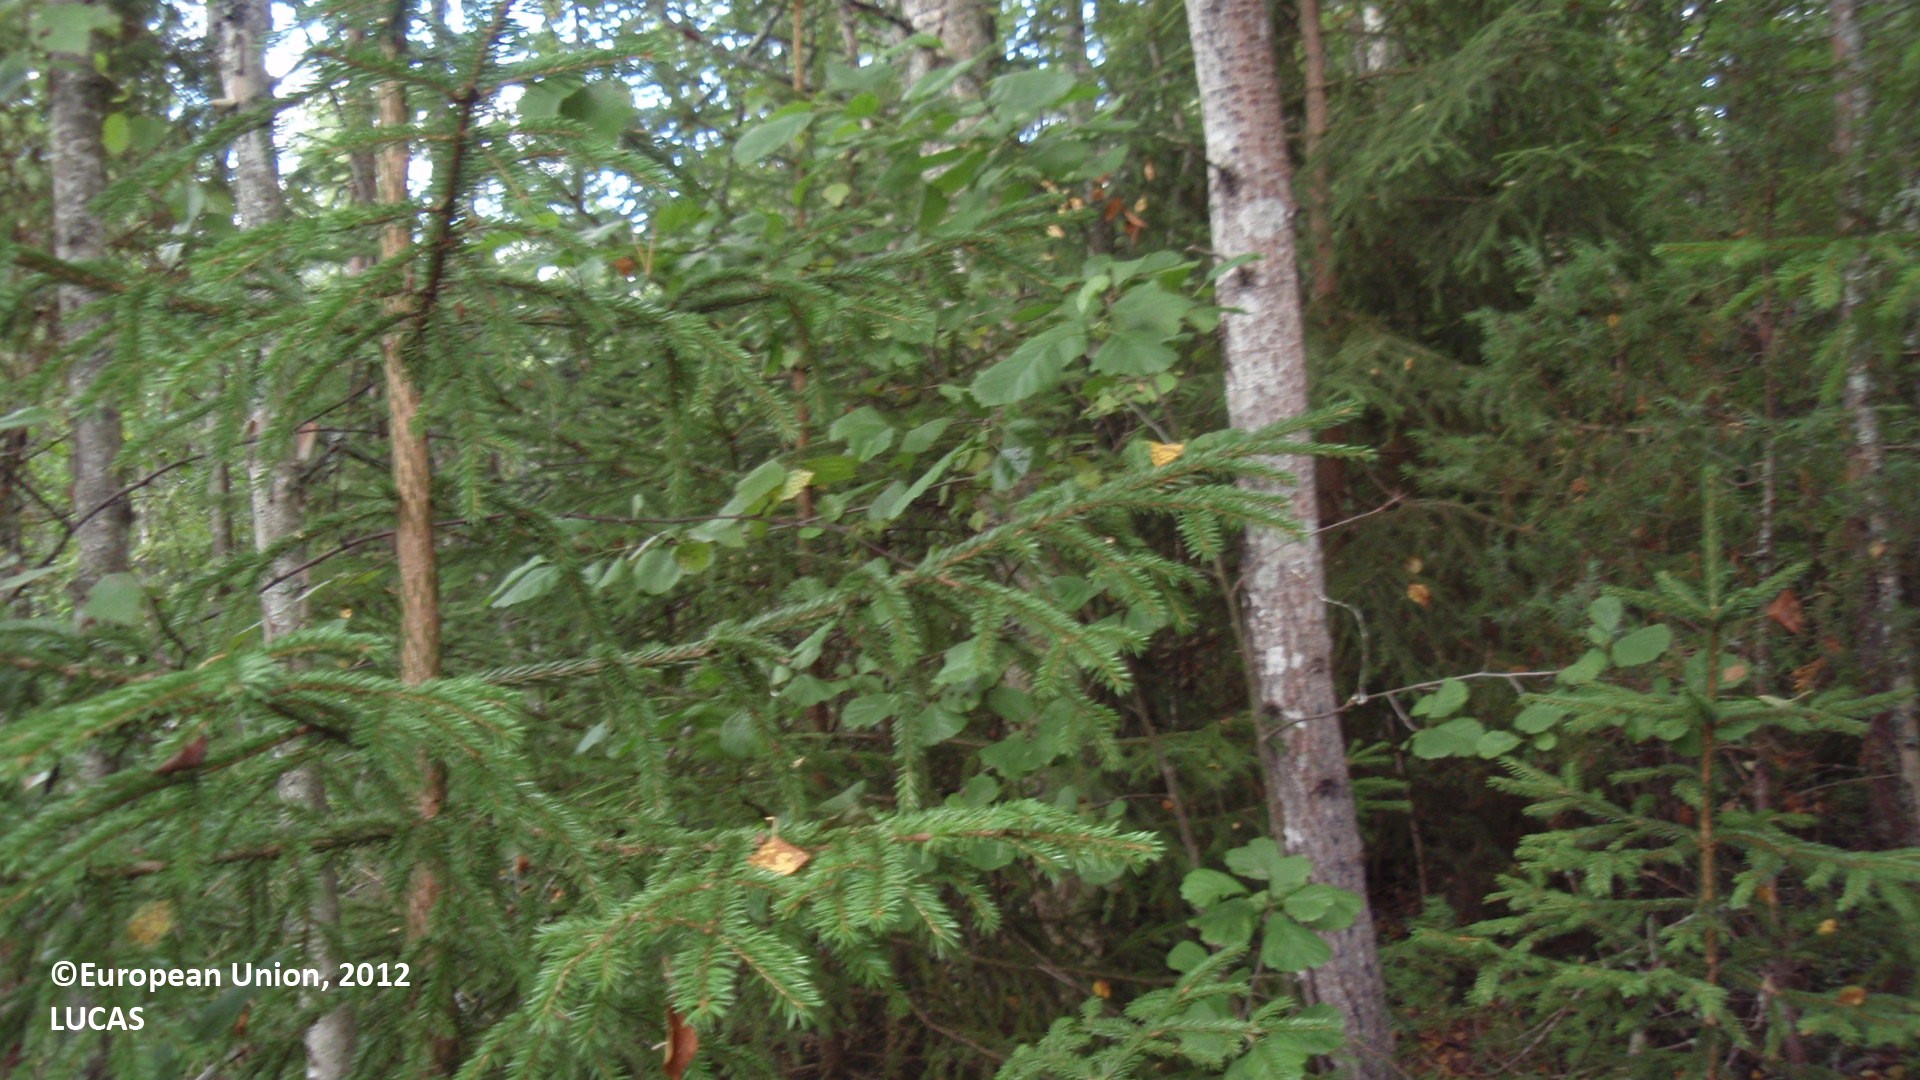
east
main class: Woodland
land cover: Broadleaved woodland
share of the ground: > 75 %
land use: Forestry
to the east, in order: Broadleaved woodland; Inland marshes; Inland water bodies
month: August
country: FI
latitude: 61.1275
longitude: 27.8098
